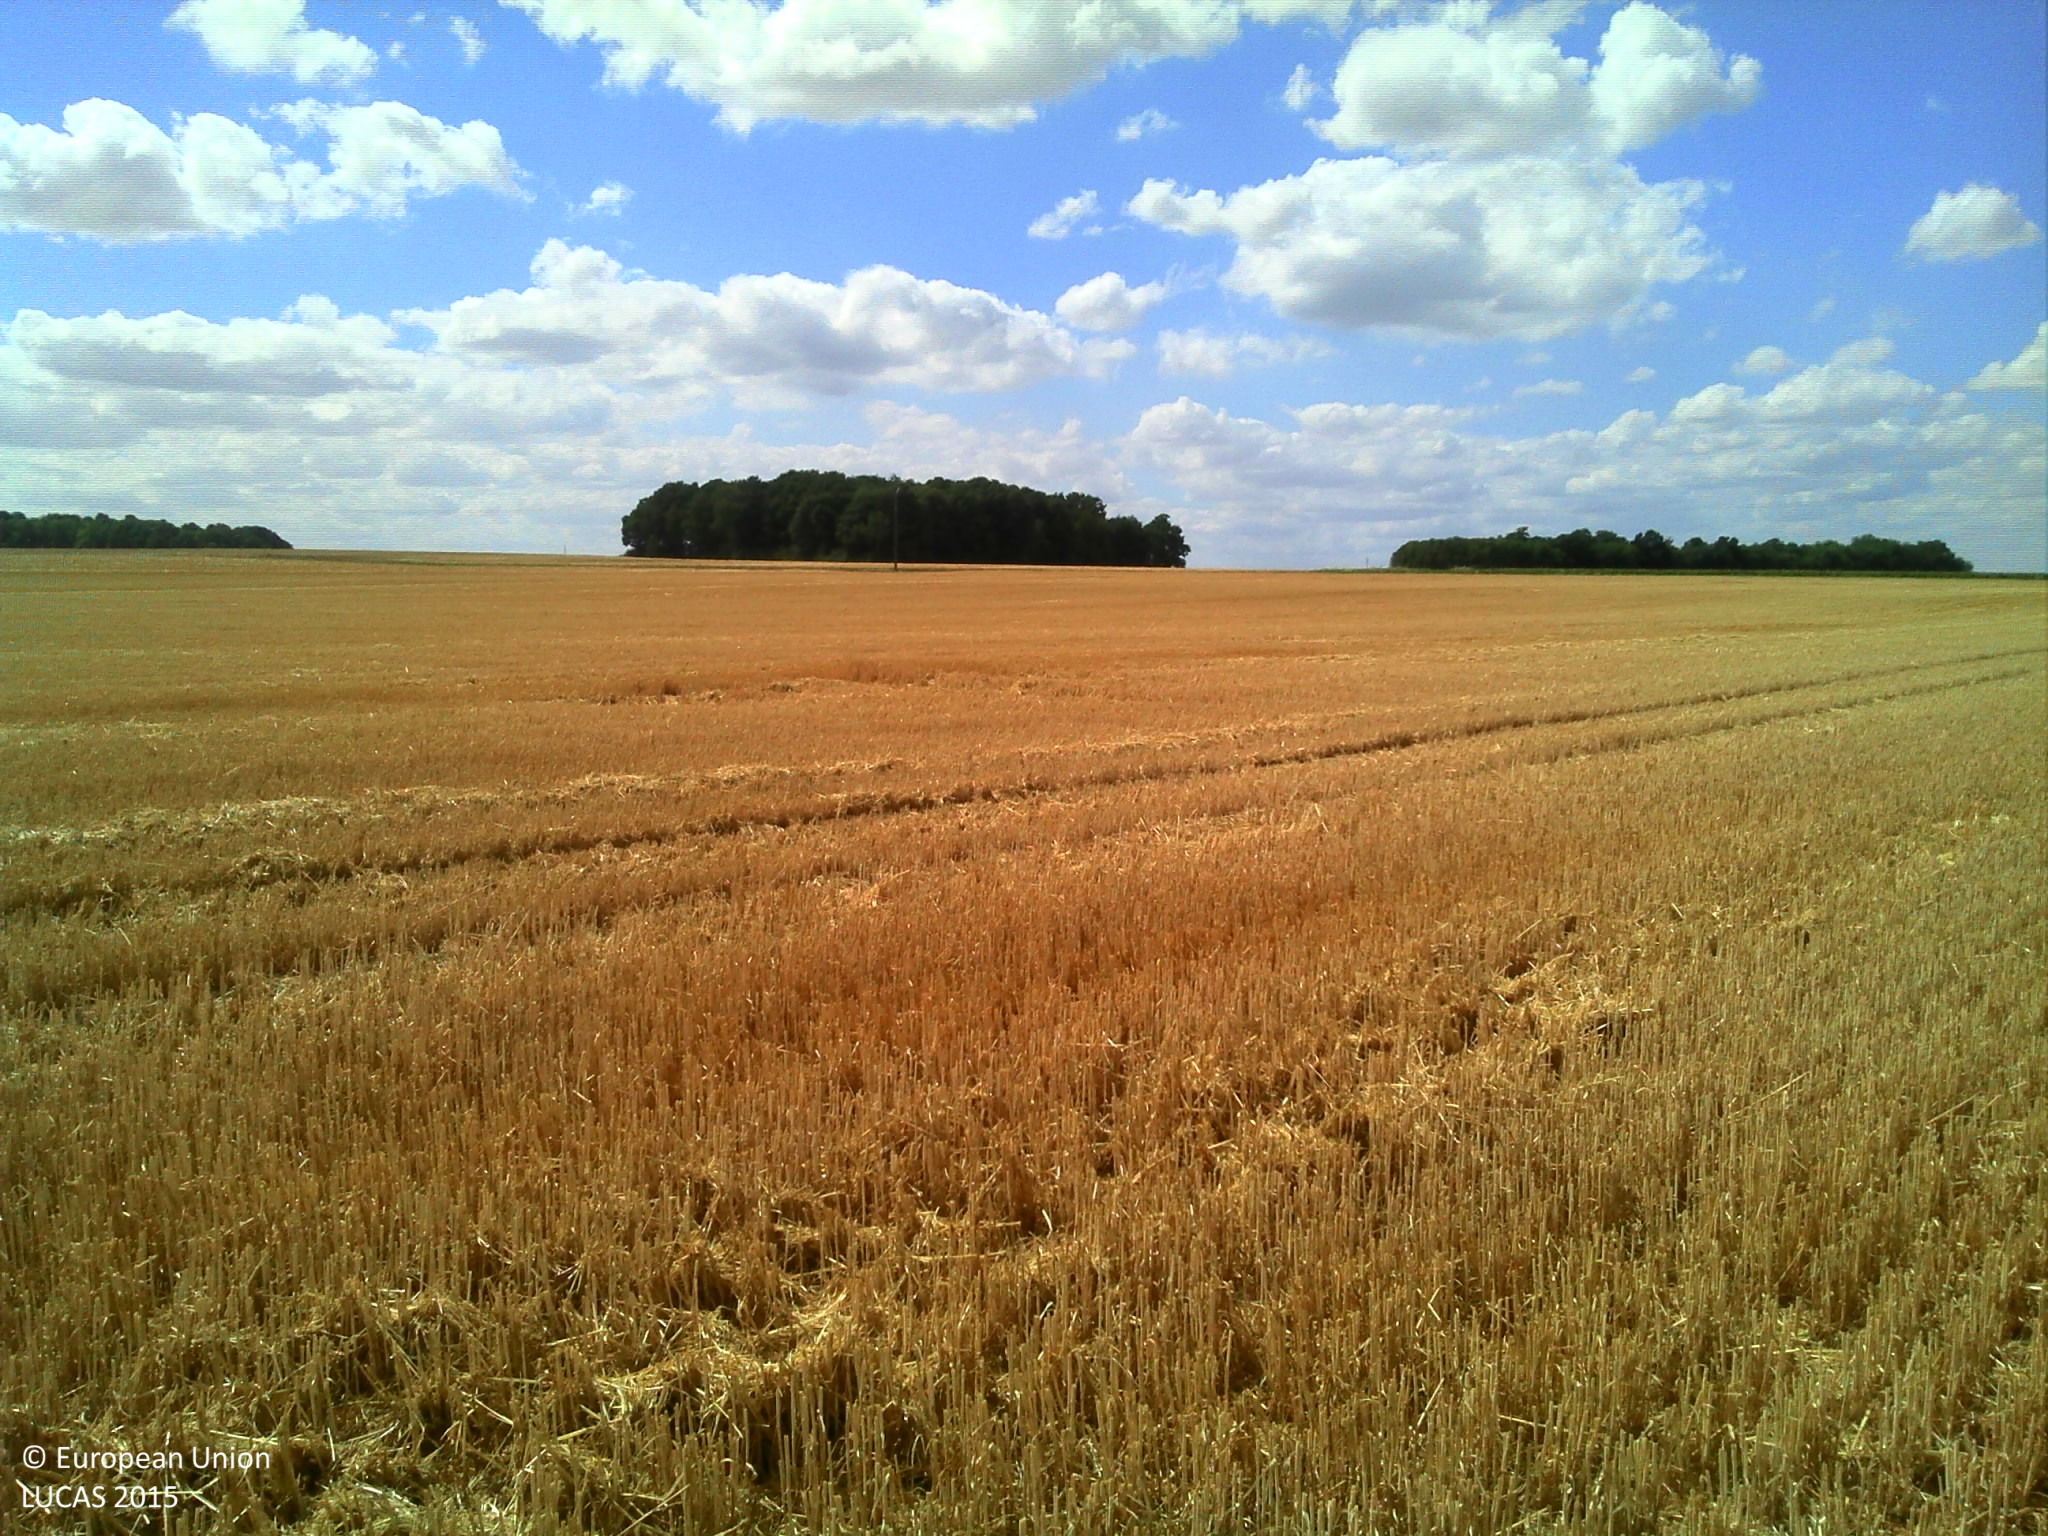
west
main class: Cropland
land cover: Common wheat
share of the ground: 10 - 25 %
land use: Agriculture (excluding fallow land and kitchen gardens)
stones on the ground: 10 - 25 %
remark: Harvested field
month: August
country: FR
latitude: 48.6190
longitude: 3.3597
